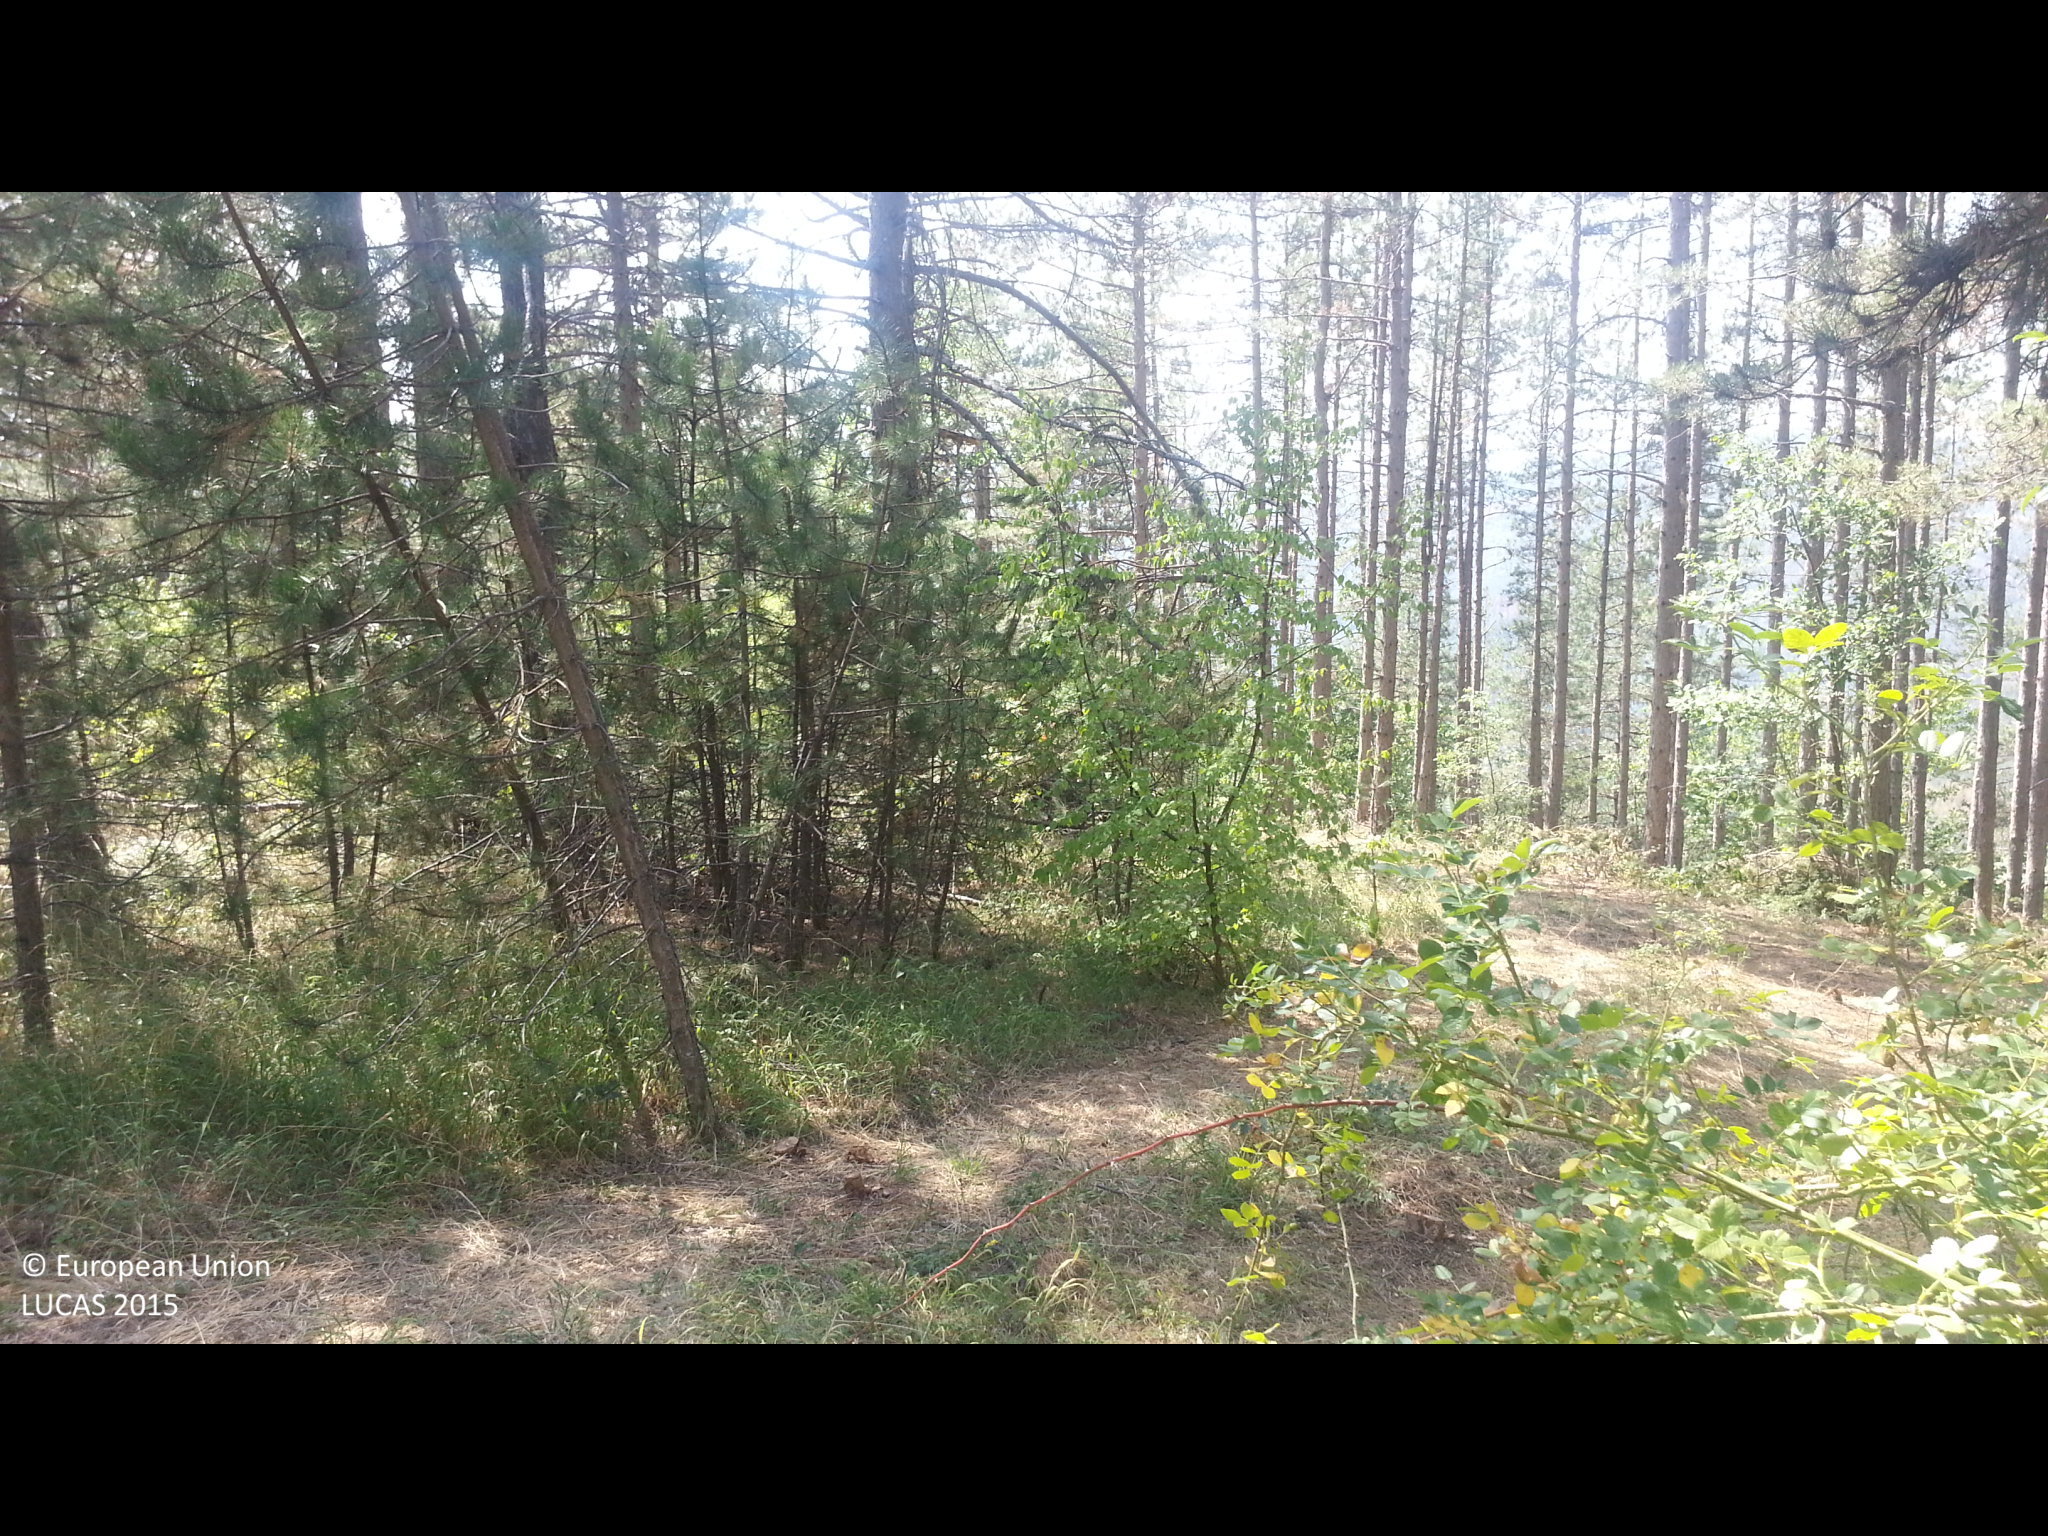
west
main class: Woodland
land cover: Pine dominated mixed woodland
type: hemiboreal forest and nemoral coniferous forest and mixed broadleaved-coniferous forest
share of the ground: > 75 %
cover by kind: coniferous forest trees 65 %, broadleaved forest trees 25 %, herbaceous plants 10 %
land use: Forestry
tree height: < 5 m
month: September
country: BG
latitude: 42.4294
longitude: 22.6023
